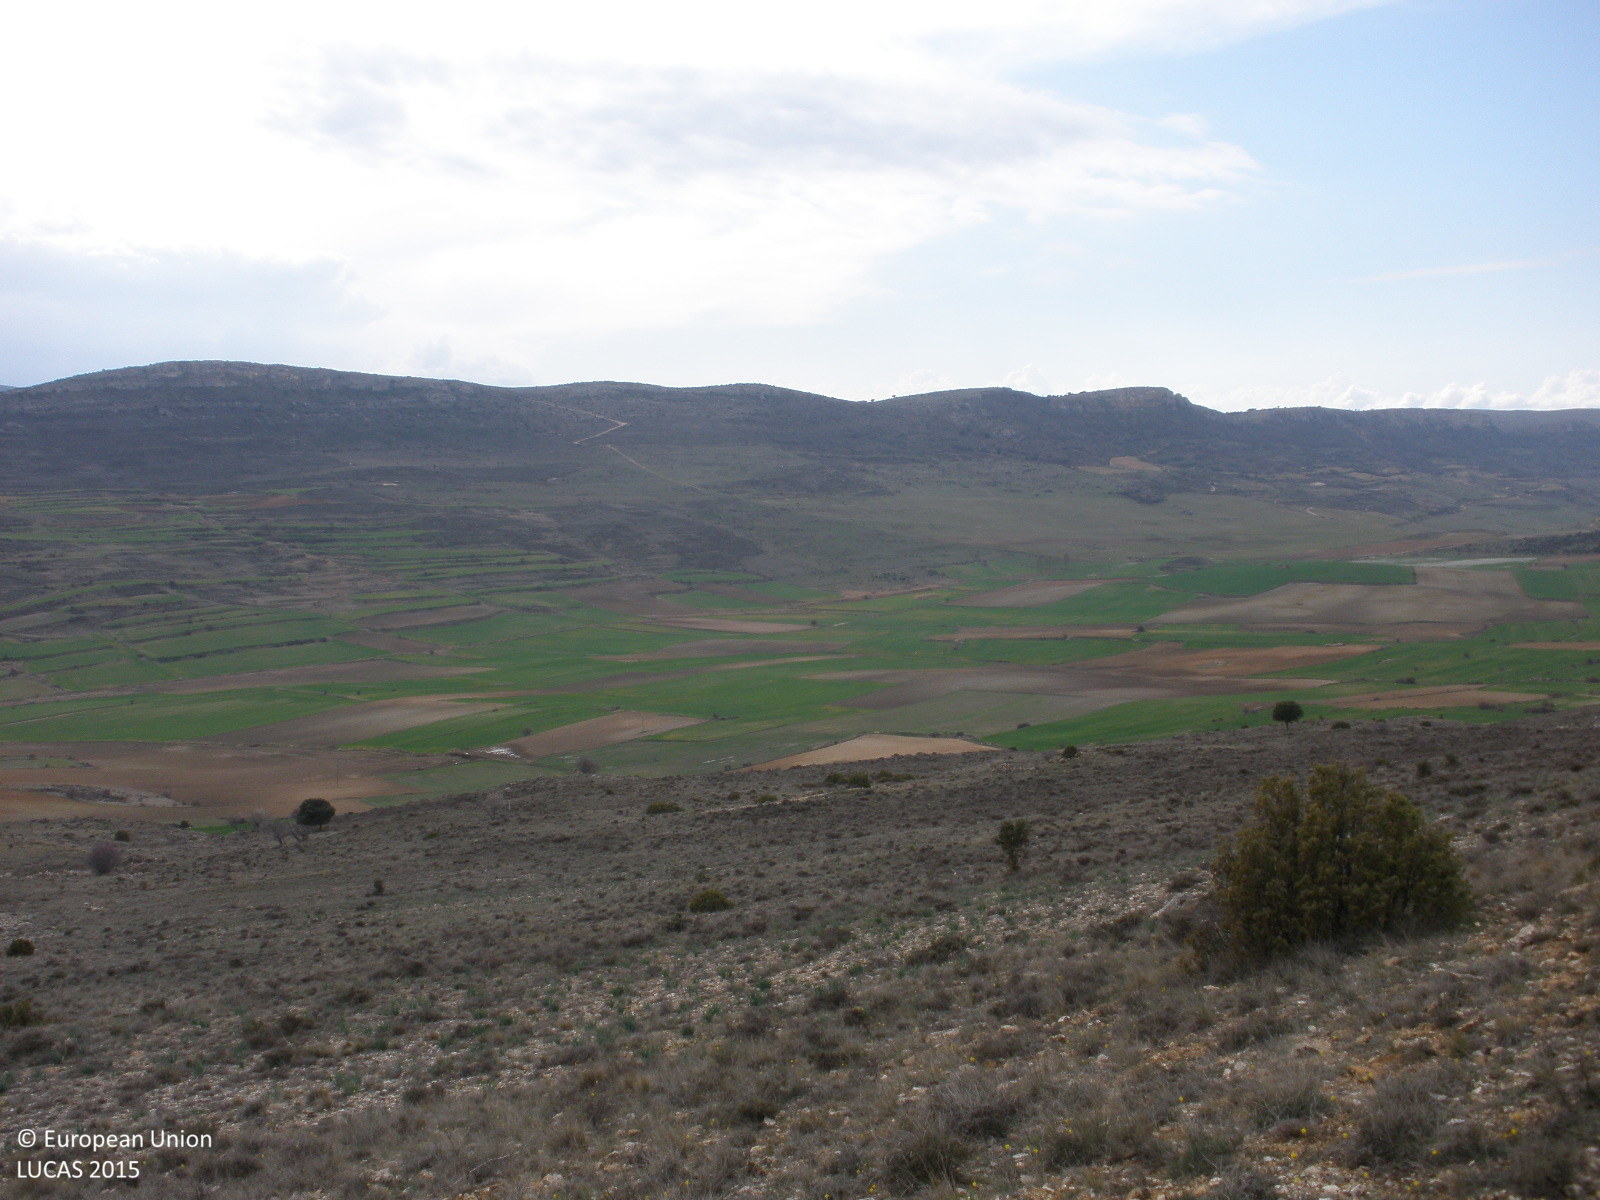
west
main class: Shrubland
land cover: Shrubland without tree cover
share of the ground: 50 - 75 %
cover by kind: consolidated bare surface 50 %, shrubs 30 %, herbaceous plants 20 %
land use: Semi-natural and natural areas not in use
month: April
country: ES
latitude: 41.0407
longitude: -1.0926
